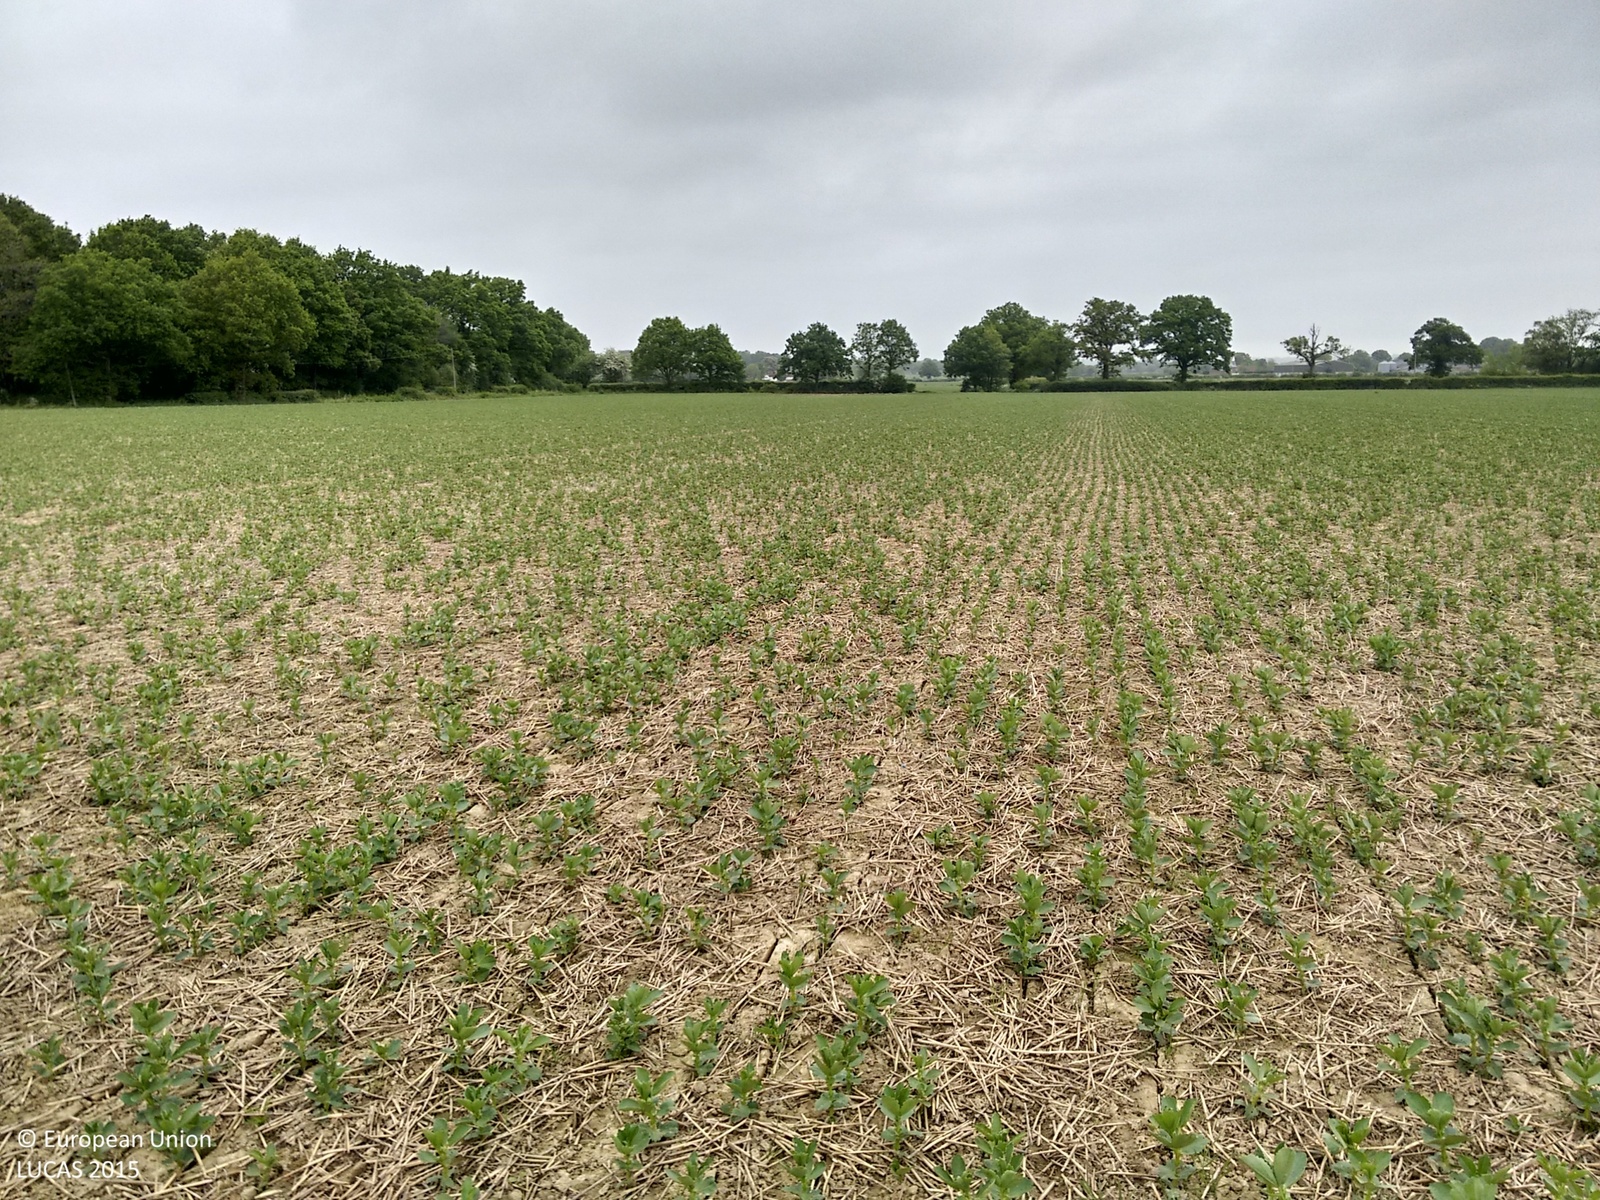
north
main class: Cropland
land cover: Dry pulses
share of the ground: 10 - 25 %
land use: Agriculture (excluding fallow land and kitchen gardens)
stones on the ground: < 10 %
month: May
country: GB
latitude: 51.1467
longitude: 0.5234
